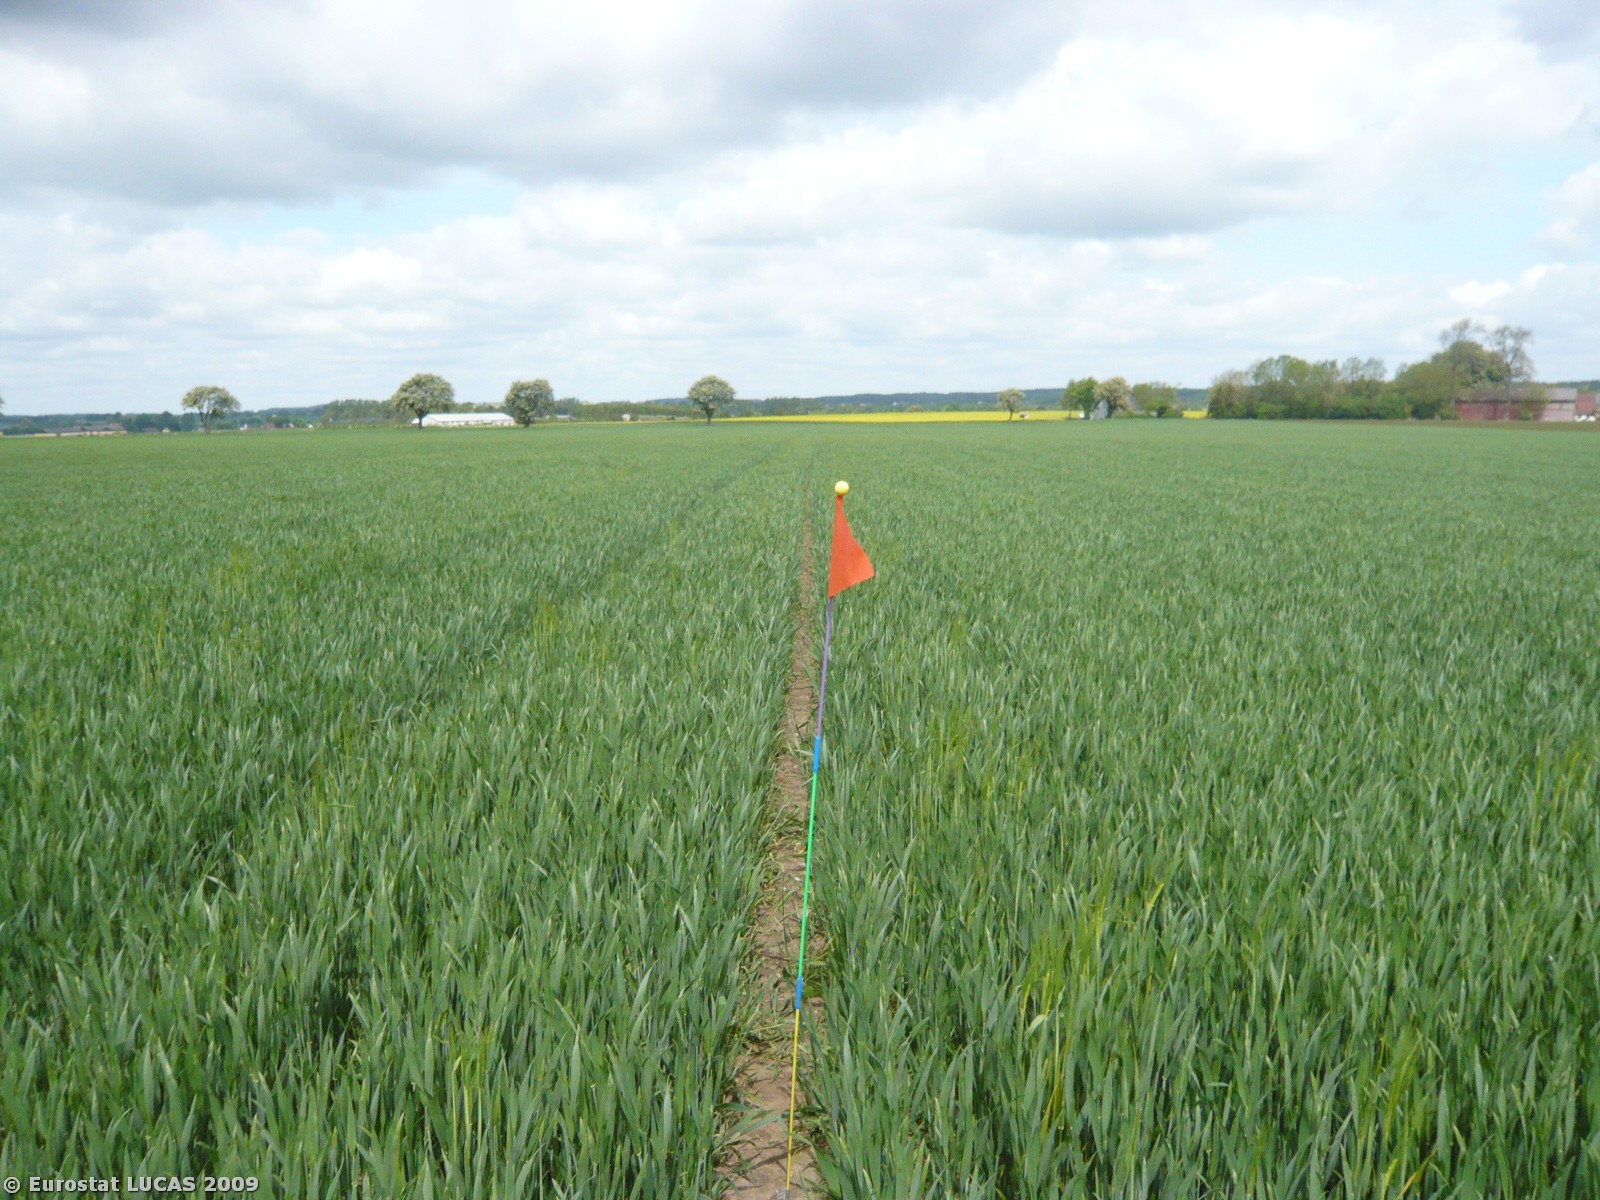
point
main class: Cropland
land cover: Common wheat
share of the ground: > 75 %
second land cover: Barley
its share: < 10 %
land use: Agriculture (excluding fallow land and kitchen gardens)
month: May
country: DK
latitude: 55.4741
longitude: 11.7862
